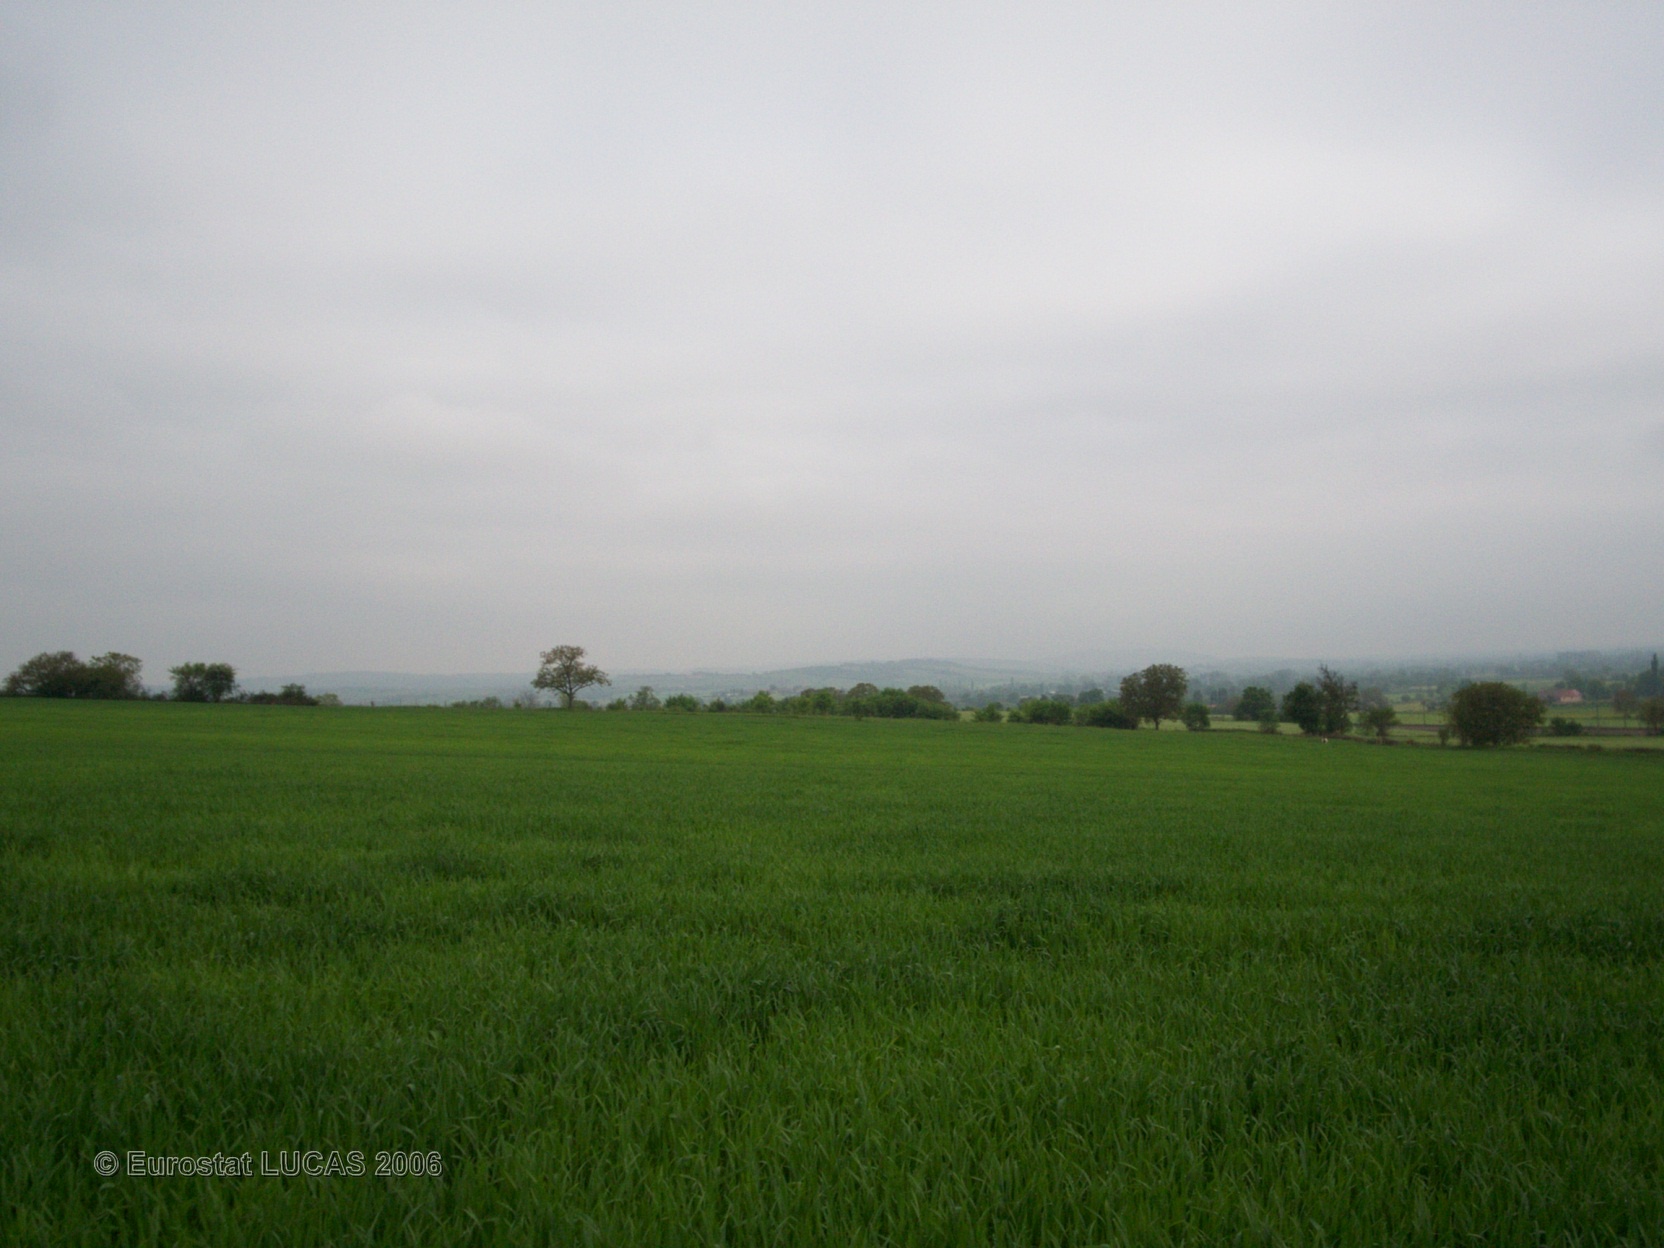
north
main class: Cropland
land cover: Common wheat
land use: Agriculture (excluding fallow land and kitchen gardens)
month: May
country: FR
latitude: 46.5239
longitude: 4.6437
